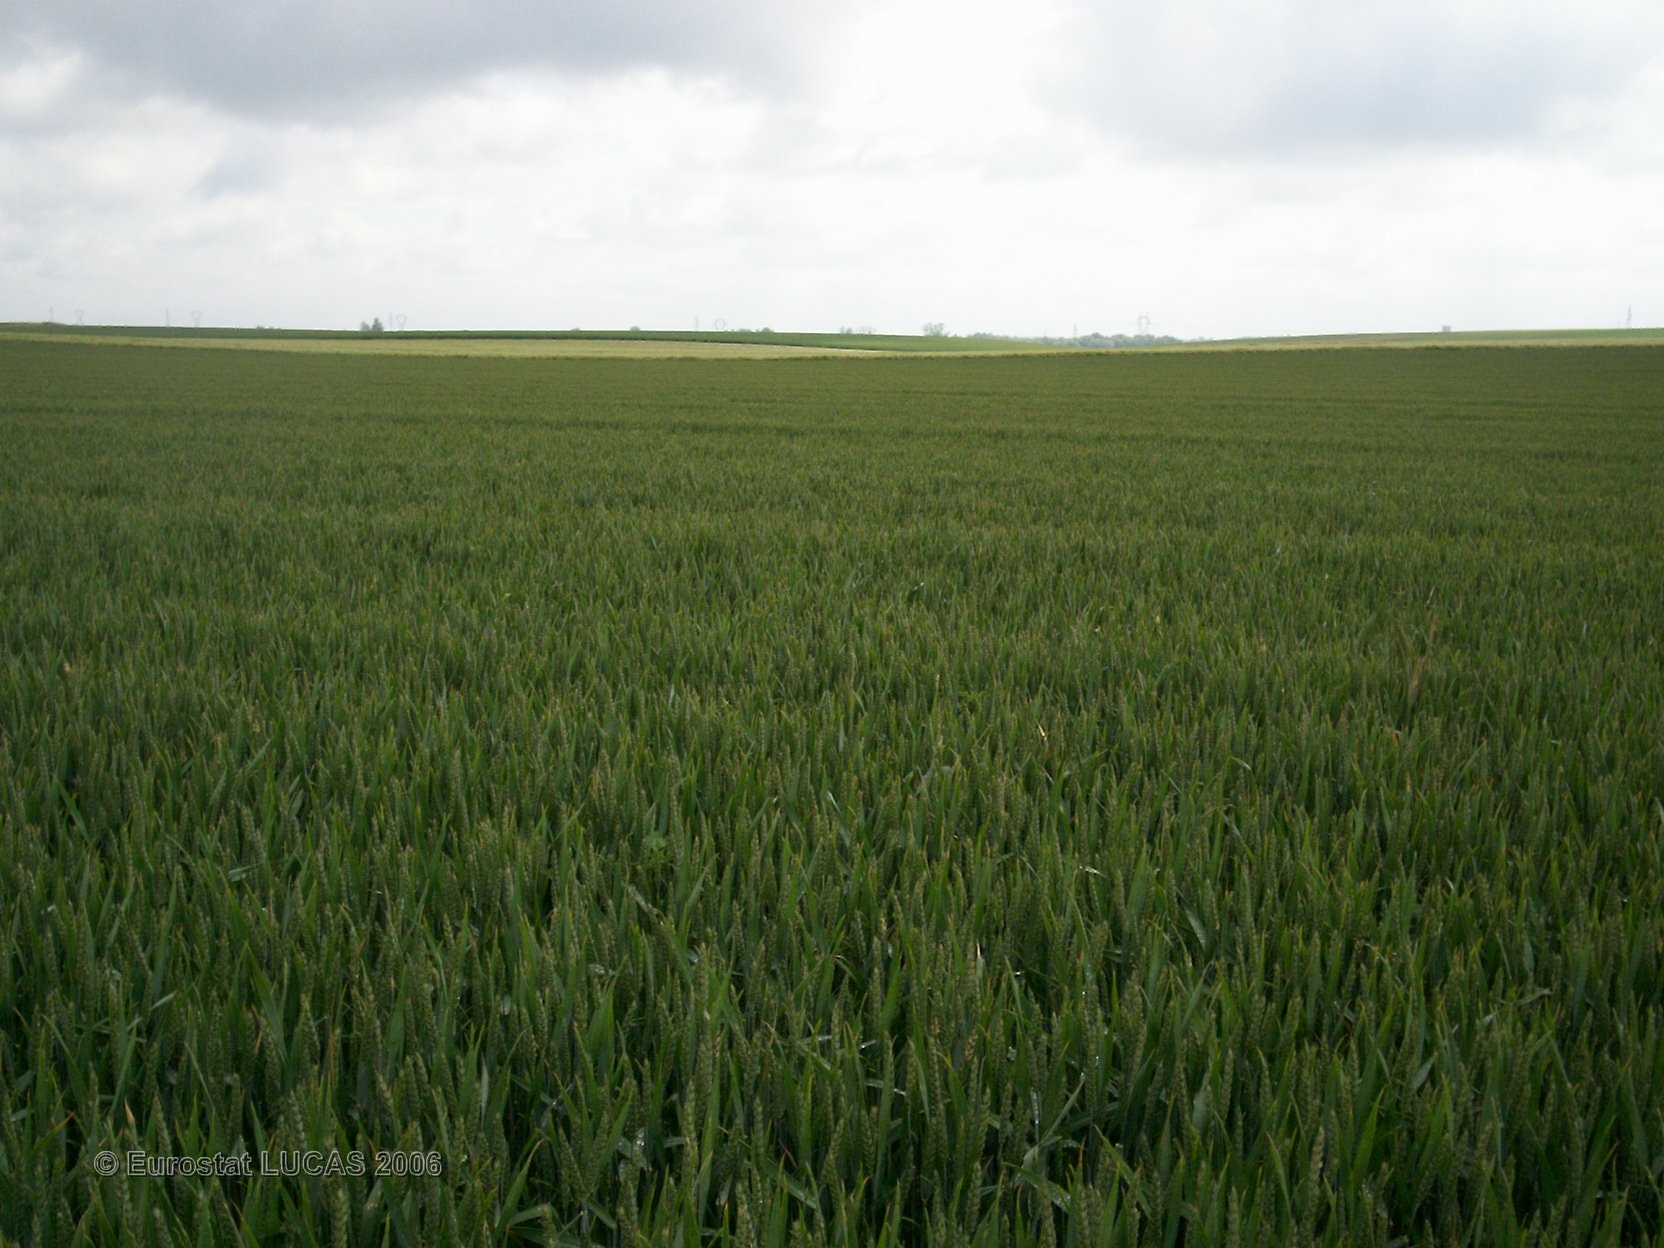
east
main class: Cropland
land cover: Common wheat
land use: Agriculture (excluding fallow land and kitchen gardens)
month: June
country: FR
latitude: 48.5723
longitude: 4.4810
